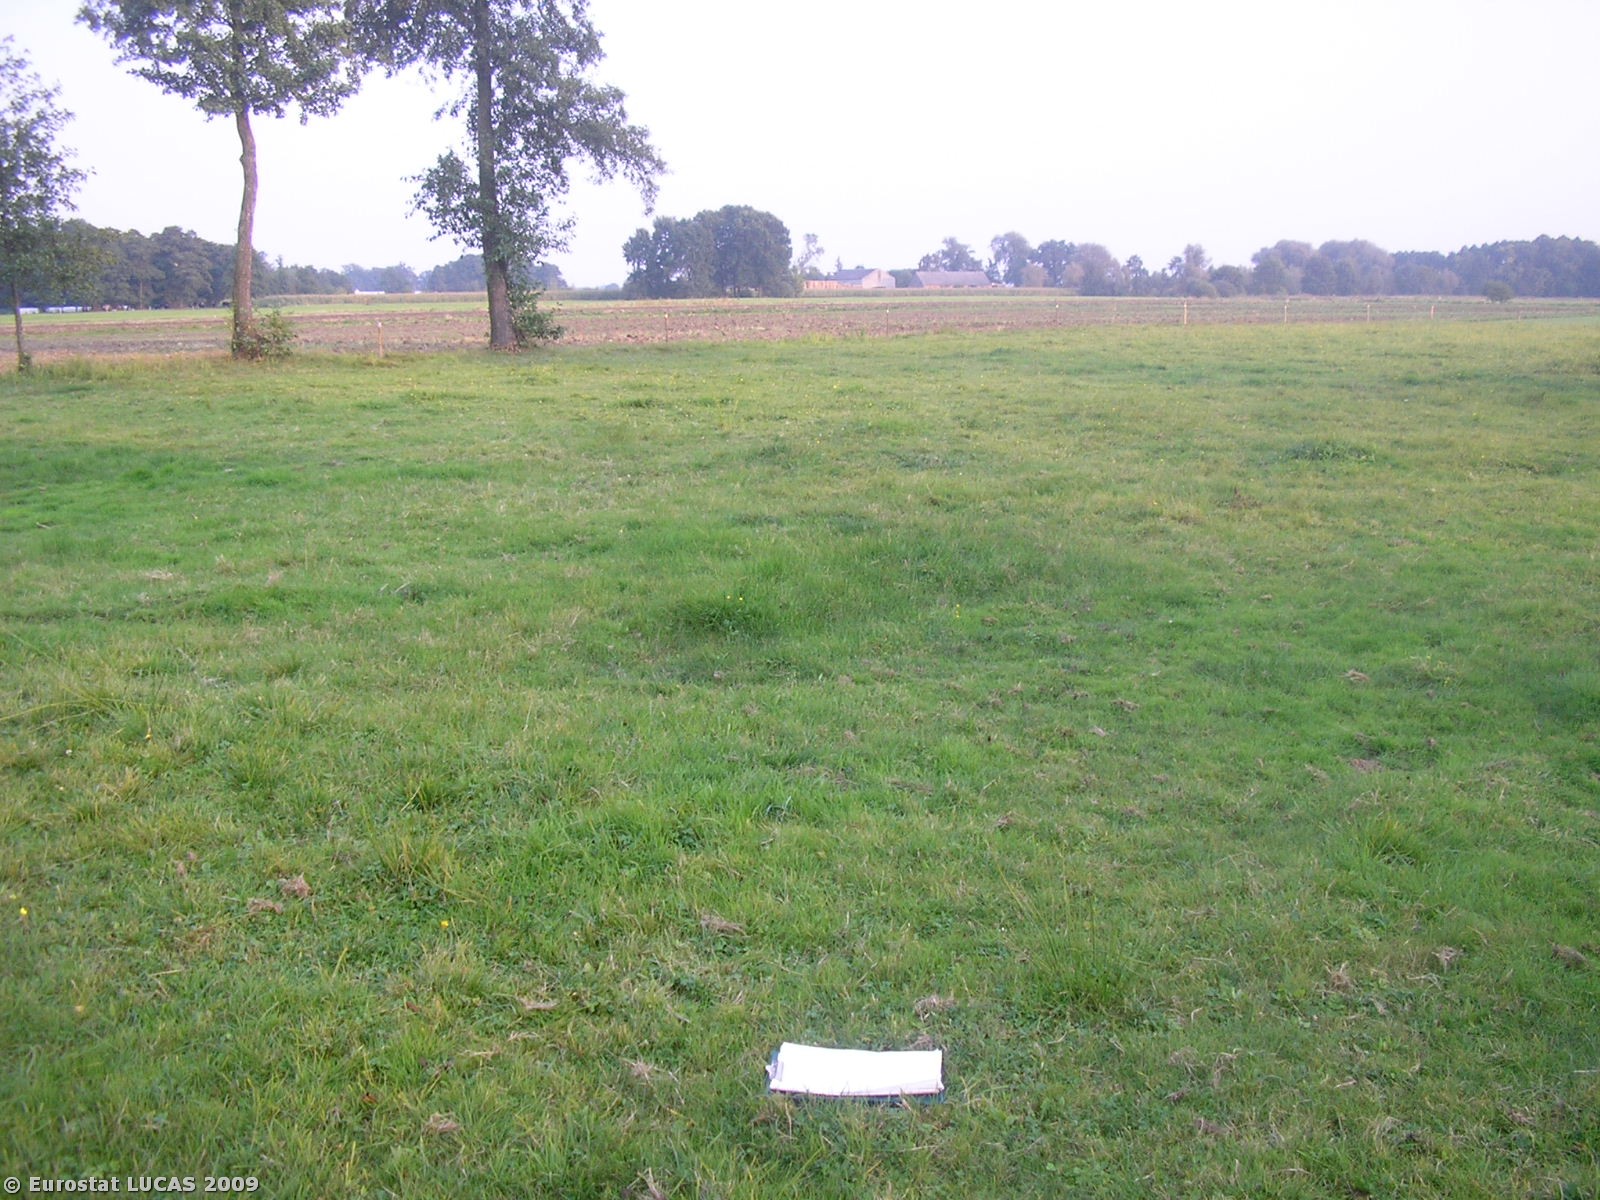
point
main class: Grassland
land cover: Grassland without tree/shrub cover
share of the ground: > 75 %
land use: Agriculture (excluding fallow land and kitchen gardens)
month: September
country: PL
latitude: 52.2131
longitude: 18.5521
